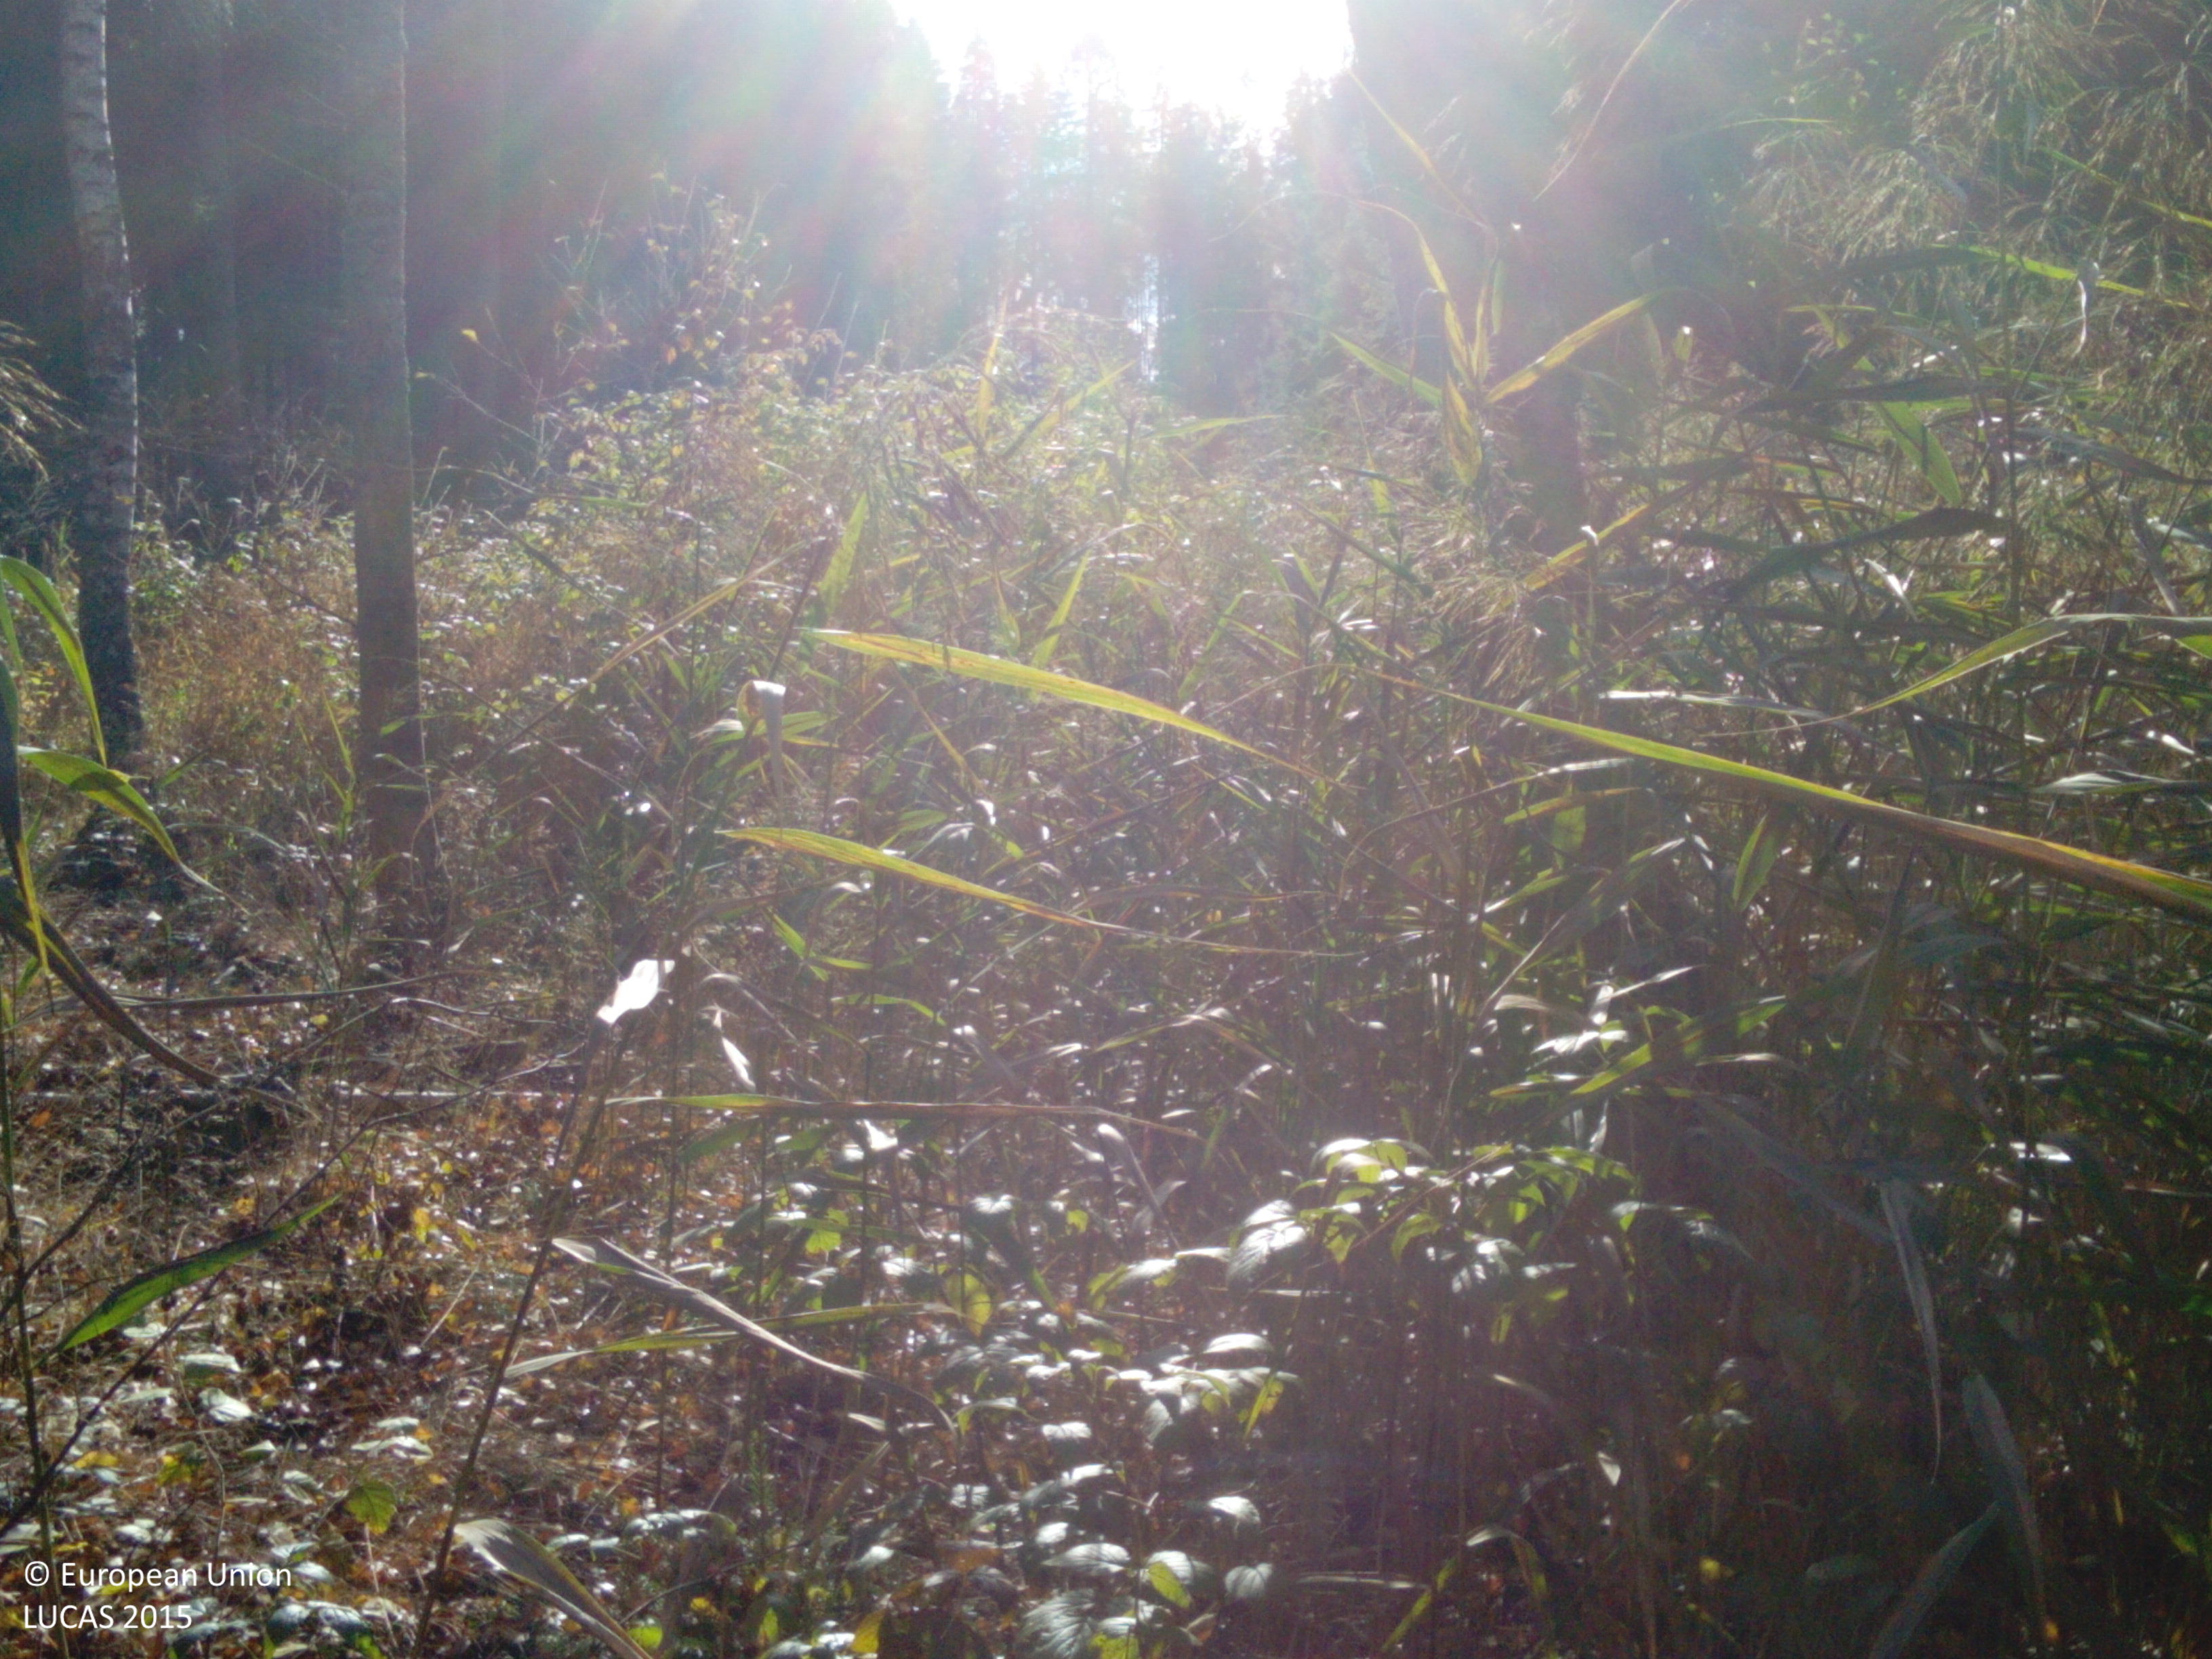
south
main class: Woodland
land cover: Broadleaved woodland
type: hemiboreal forest and nemoral coniferous forest and mixed broadleaved-coniferous forest
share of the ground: 50 - 75 %
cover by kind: broadleaved forest trees 65 %, herbaceous plants 25 %, coniferous forest trees 10 %
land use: Forestry
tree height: > 5 m
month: October
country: SE
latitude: 59.0098
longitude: 16.3146
